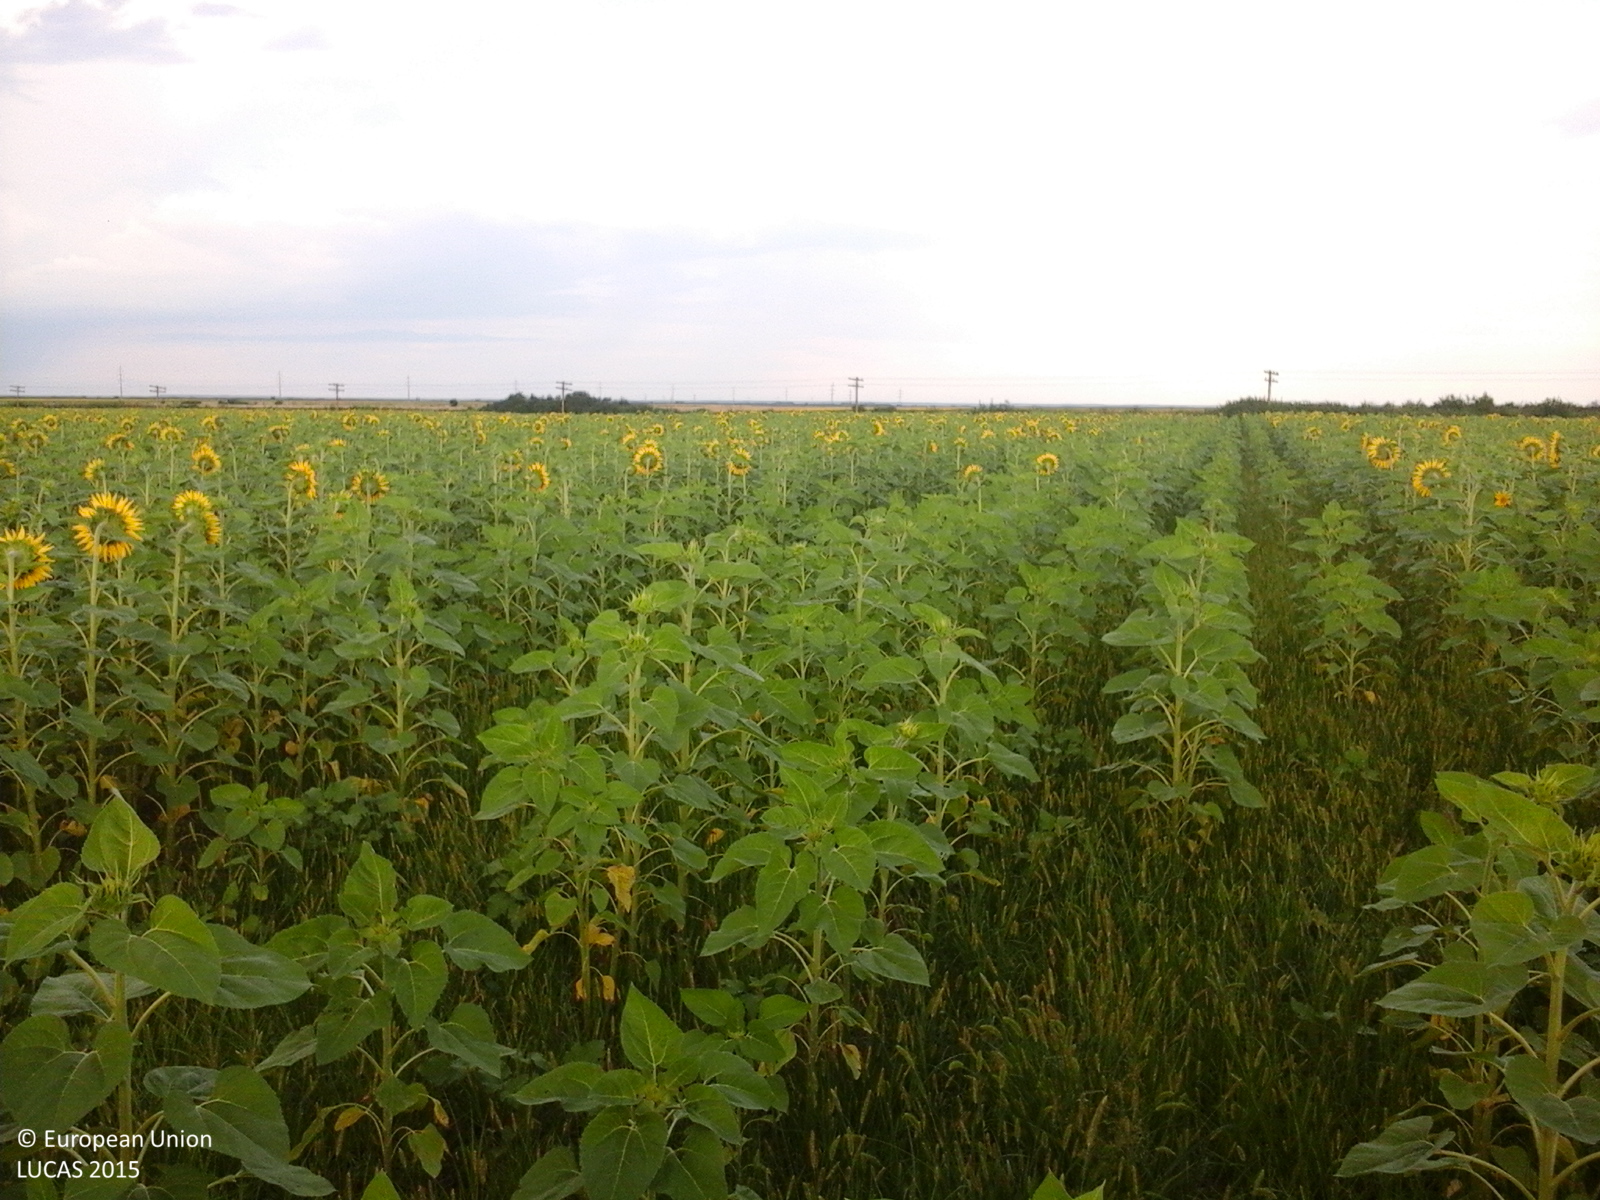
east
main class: Cropland
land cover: Sunflower
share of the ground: > 75 %
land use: Agriculture (excluding fallow land and kitchen gardens)
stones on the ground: < 10 %
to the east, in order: Sunflower; Grass margins; Electric lines; Abandoned hedges; Railways; Spontaneously vegetated surfaces; Common wheat
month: July
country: RO
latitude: 44.1479
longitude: 24.3804
